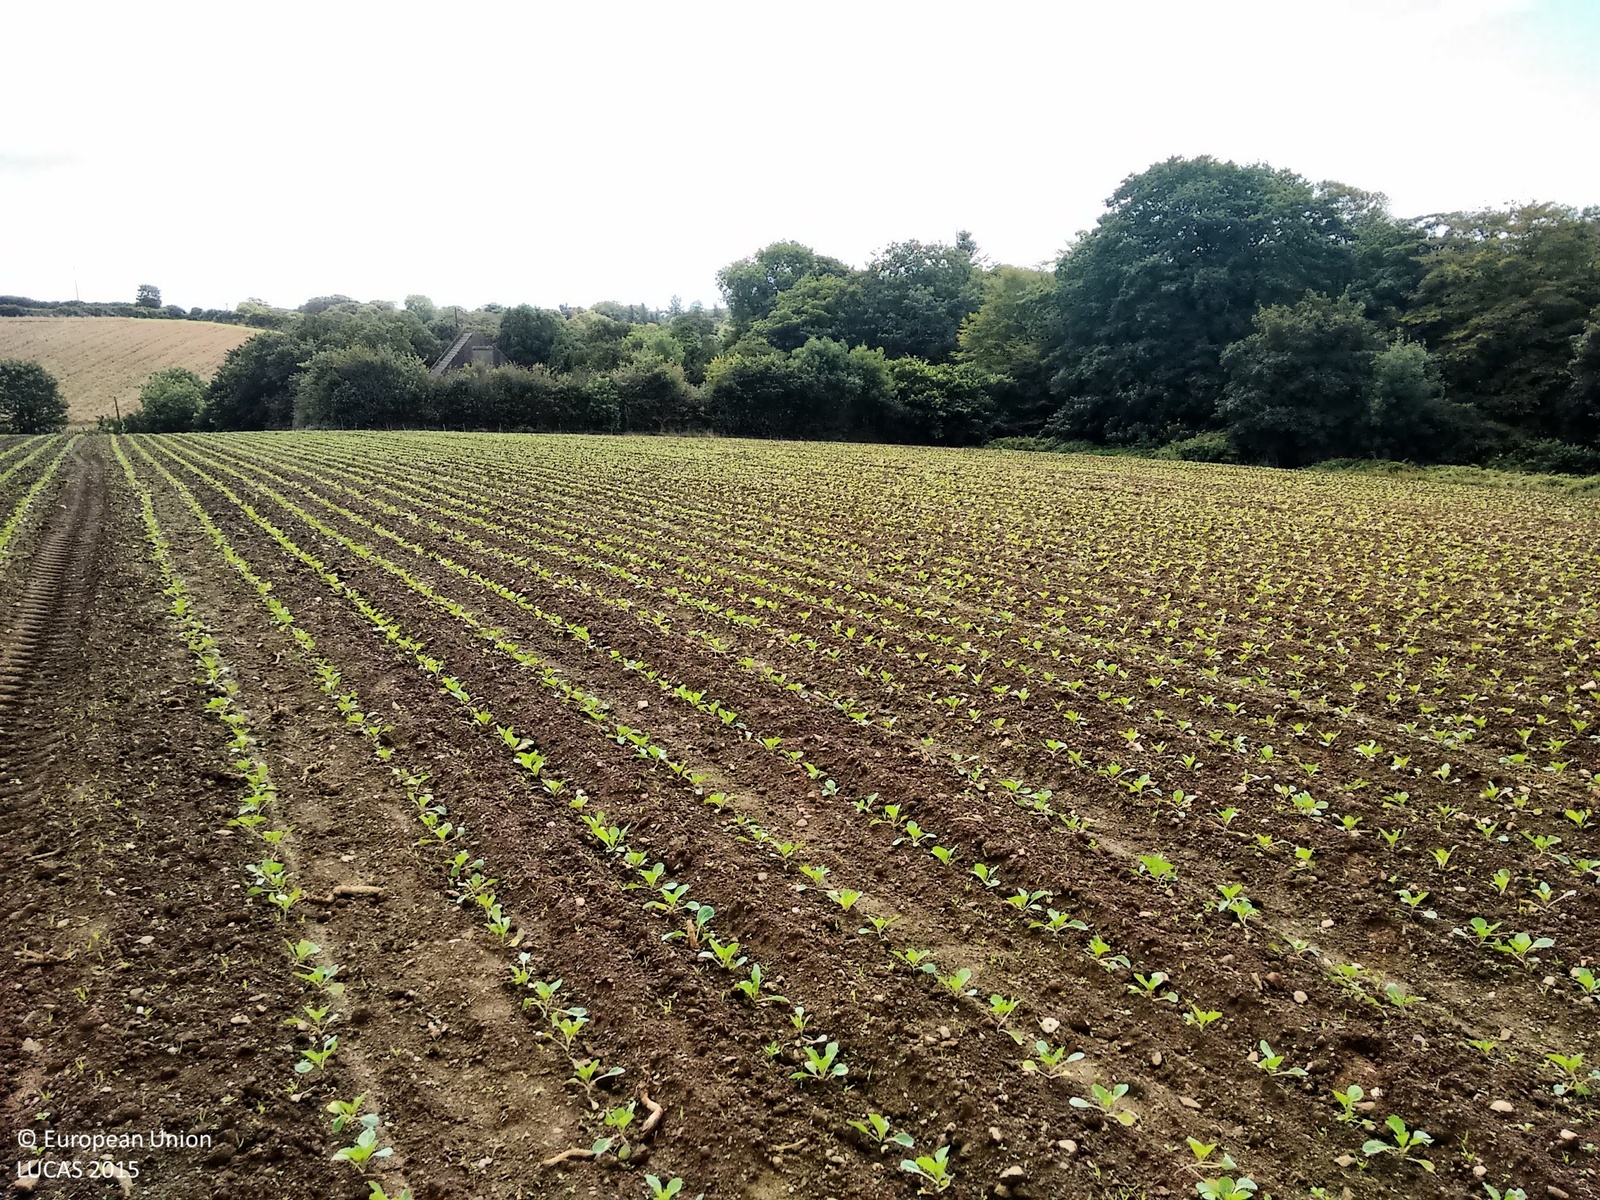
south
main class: Cropland
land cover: Other fresh vegetables
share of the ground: < 10 %
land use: Agriculture (excluding fallow land and kitchen gardens)
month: September
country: GB
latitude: 50.1319
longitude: -5.3012
